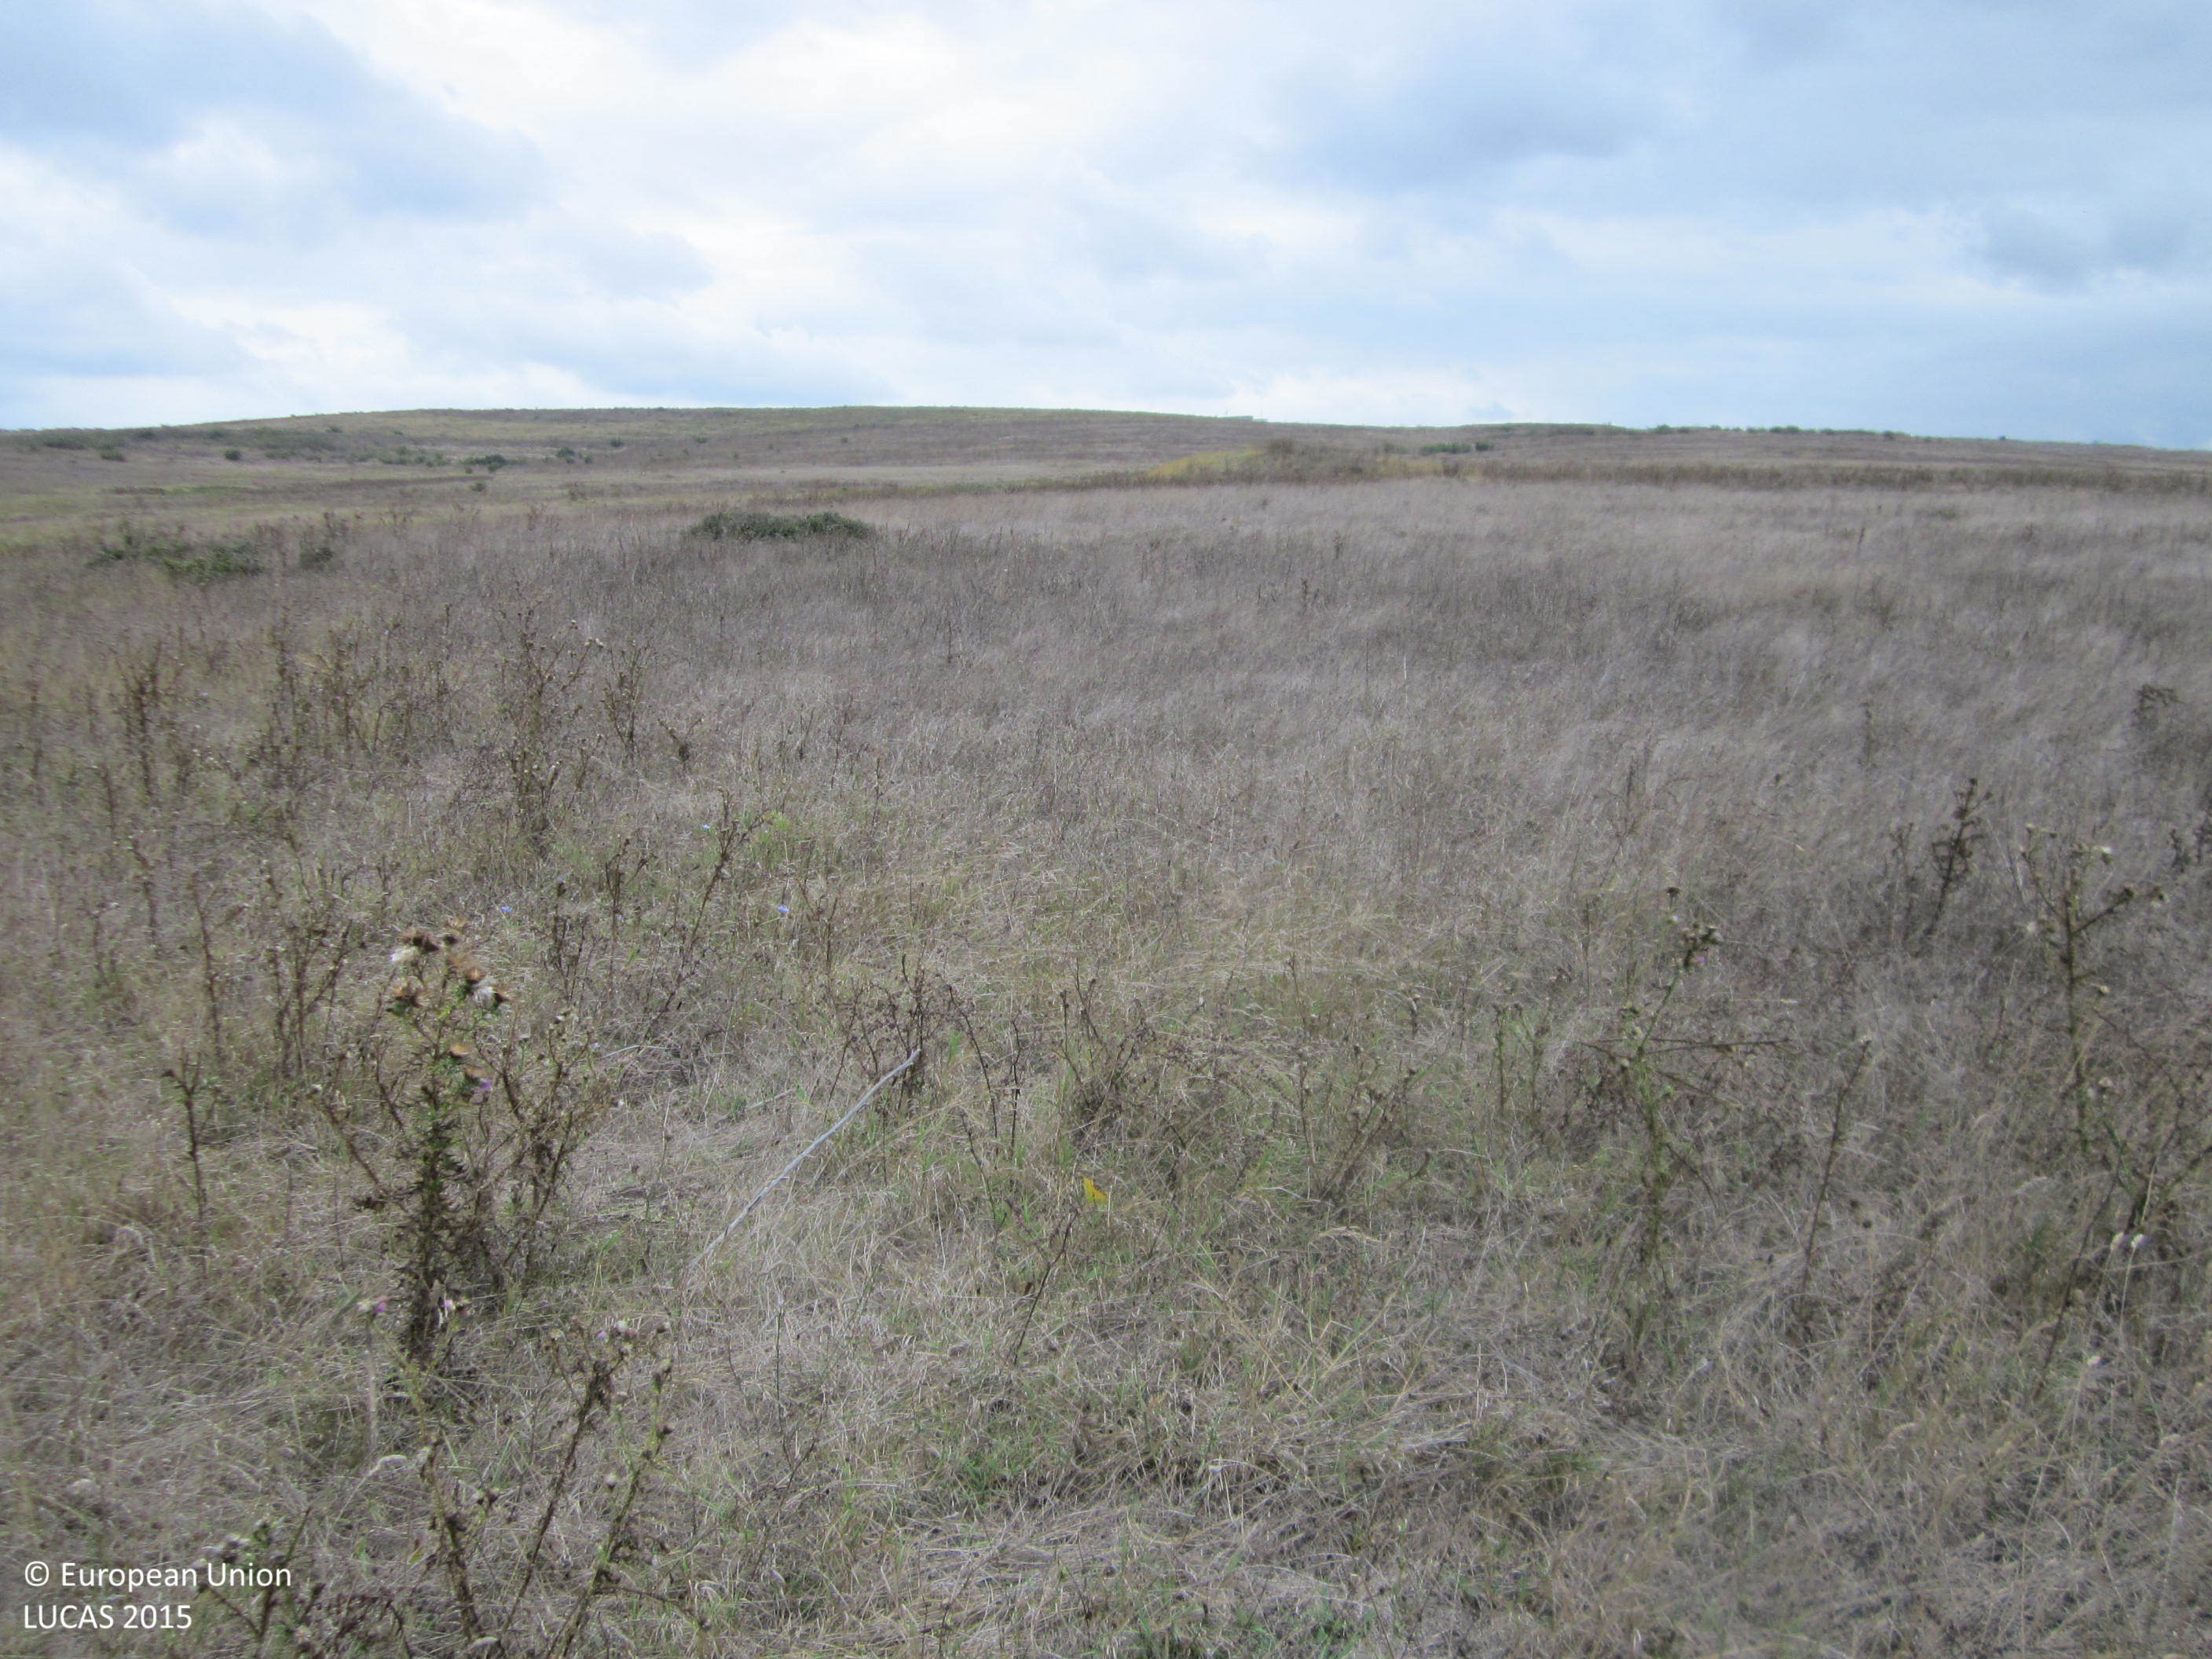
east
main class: Grassland
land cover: Grassland without tree/shrub cover
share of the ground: > 75 %
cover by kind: herbaceous plants 100 %
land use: Agriculture (excluding fallow land and kitchen gardens)
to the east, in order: Grassland without tree/shrub cover; Tracks; Grassland without tree/shrub cover
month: September
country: BG
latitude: 42.4569
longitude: 27.3190
